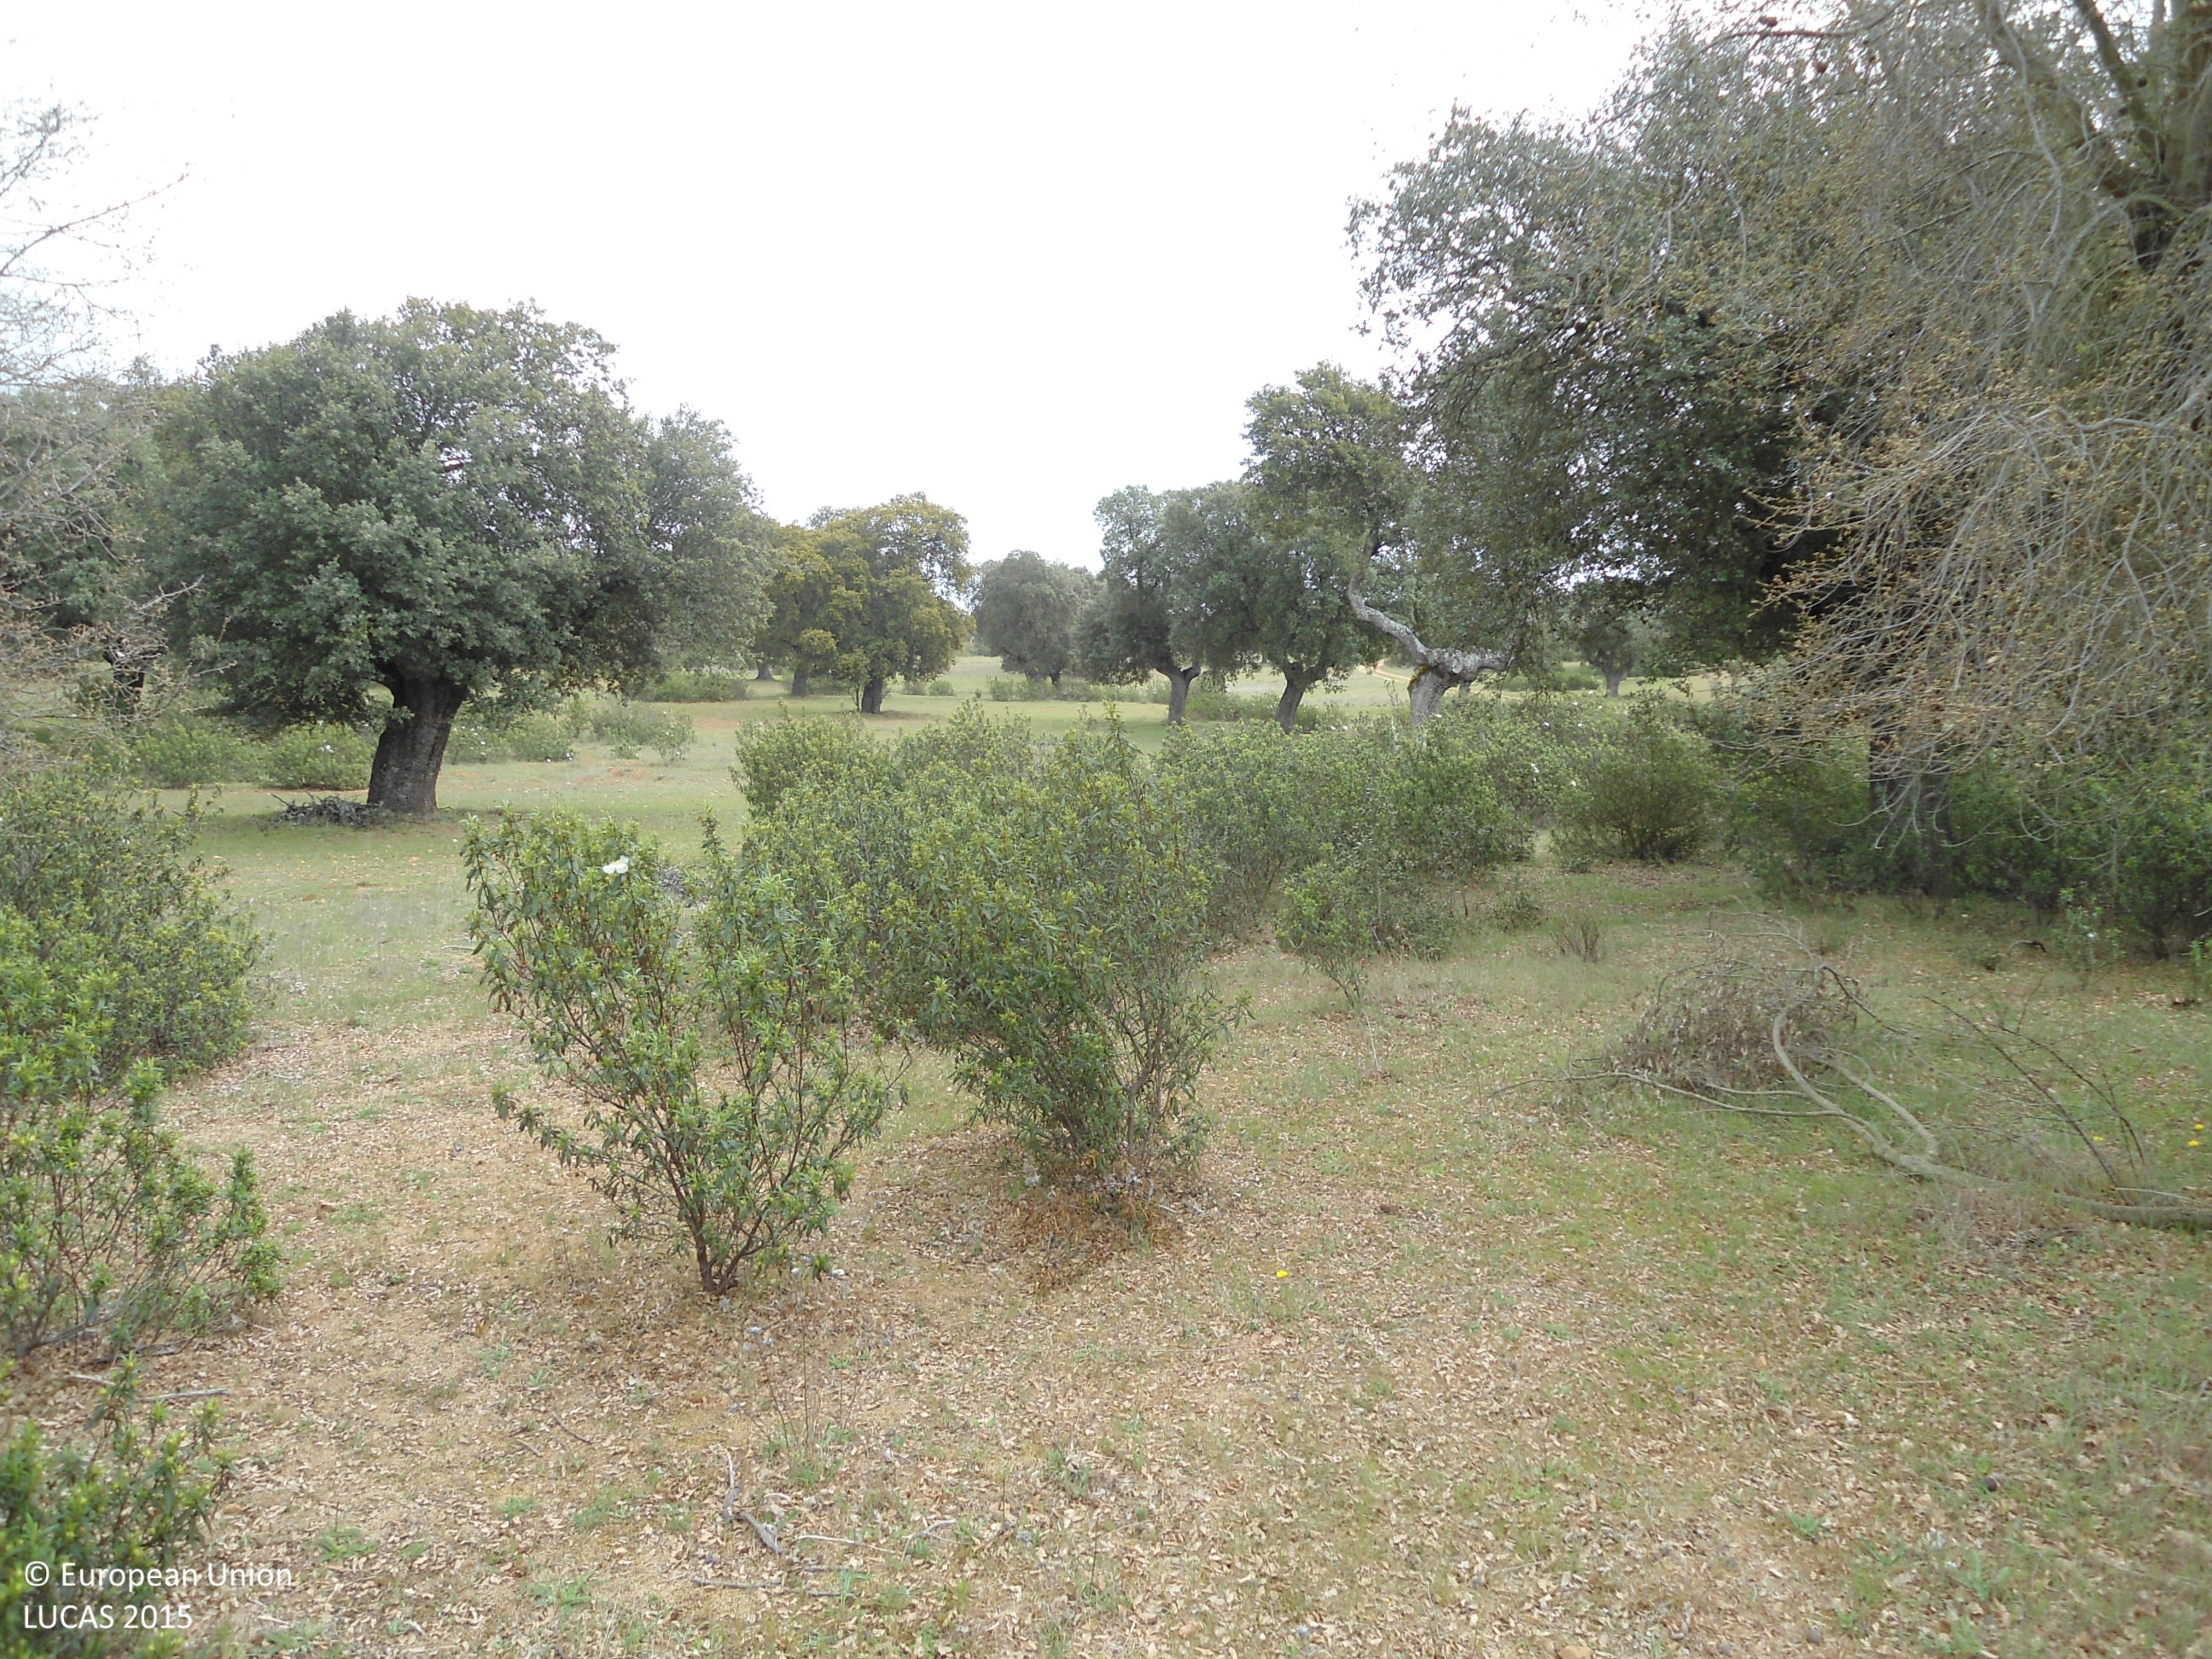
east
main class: Grassland
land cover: Spontaneously vegetated surfaces
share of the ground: > 75 %
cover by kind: herbaceous plants 90 %, shrubs 5 %, unconsolidated bare surface 5 %
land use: Agriculture (excluding fallow land and kitchen gardens)
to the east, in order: Spontaneously vegetated surfaces; Broadleaved woodland; Shrubland with sparse tree cover; Spontaneously vegetated surfaces; Broadleaved woodland; Spontaneously vegetated surfaces; Grassland without tree/shrub cover; Electric lines; Grassland without tree/shrub cover; Spontaneously vegetated surfaces; Grassland with sparse tree/shrub cover; Spontaneously vegetated surfaces; Grassland with sparse tree/shrub cover
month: April
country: ES
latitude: 41.6276
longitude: -5.8994
